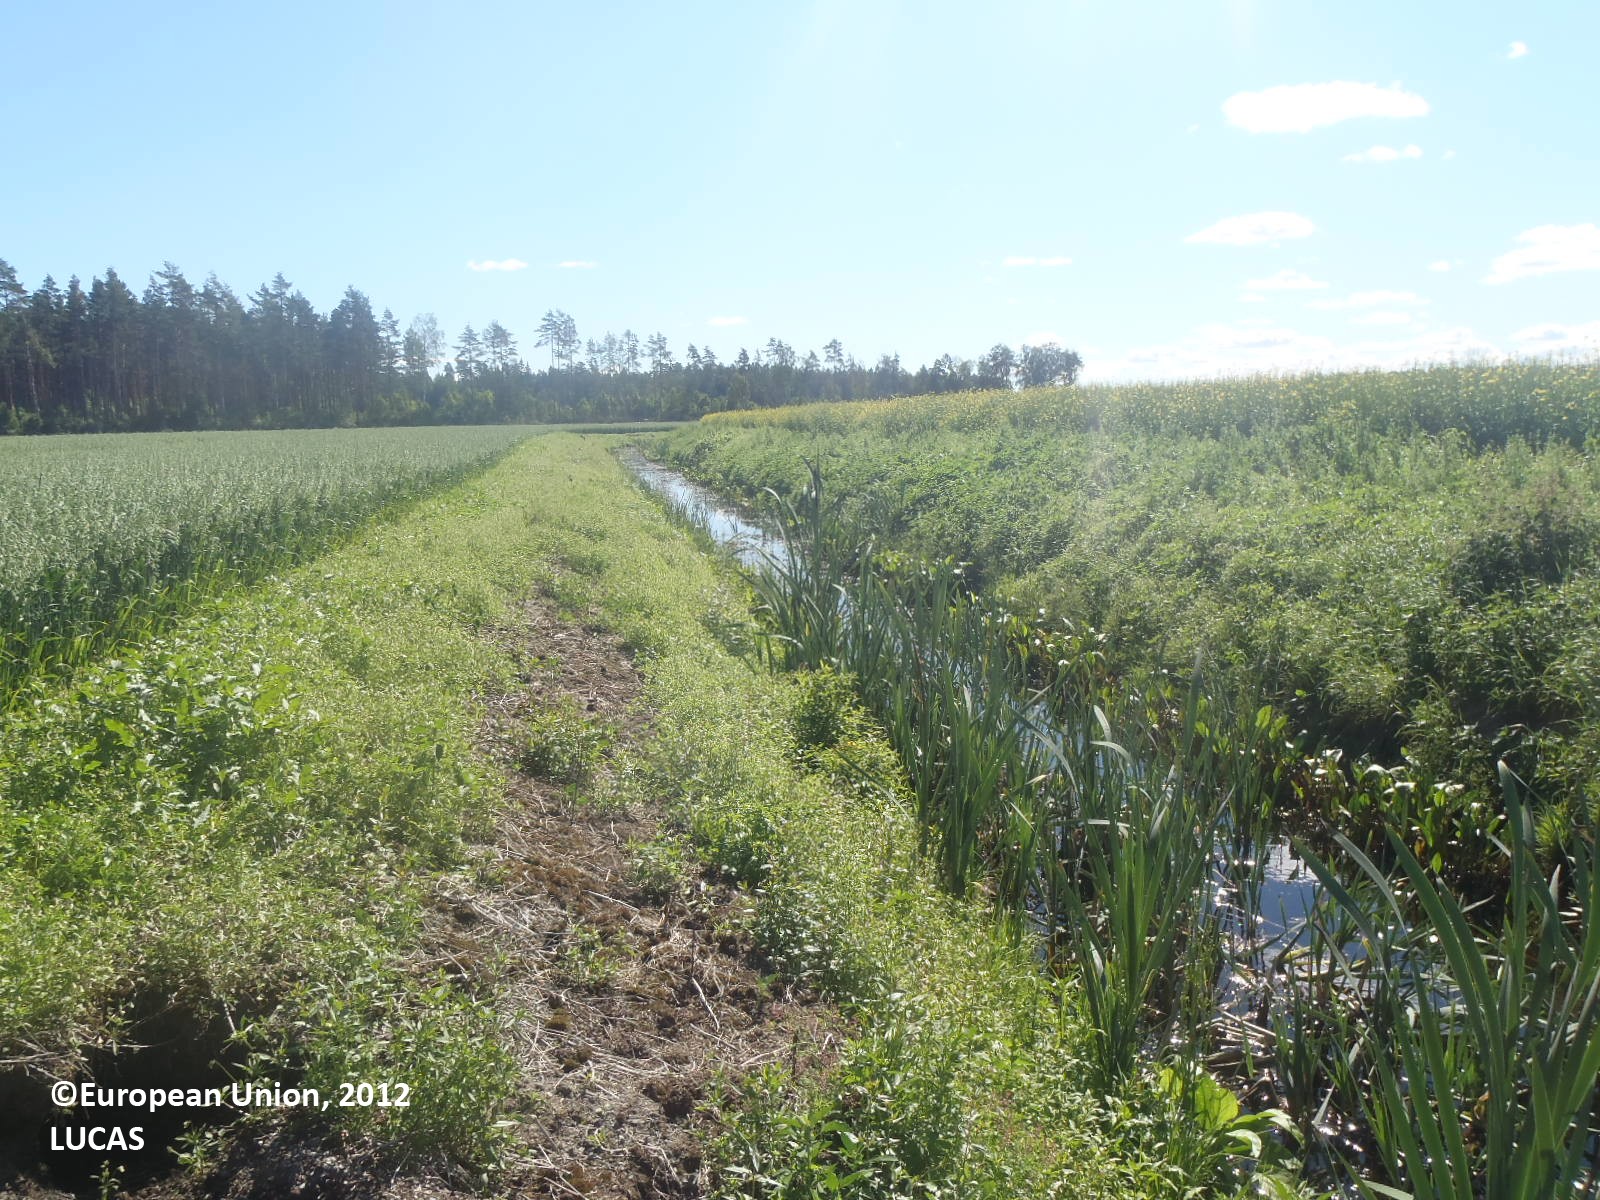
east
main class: Cropland
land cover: Oats
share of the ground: > 75 %
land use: Agriculture (excluding fallow land and kitchen gardens)
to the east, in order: Grass margins; Oats; Grass margins; Other bare soil; Ditches and canals; Other bare soil; Ditches and canals; Abandoned hedges; Pine dominated coniferous woodland; Abandoned hedges; Ditches and canals; Abandoned hedges; Pine dominated coniferous woodland
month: July
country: FI
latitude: 61.0438
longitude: 21.8902
